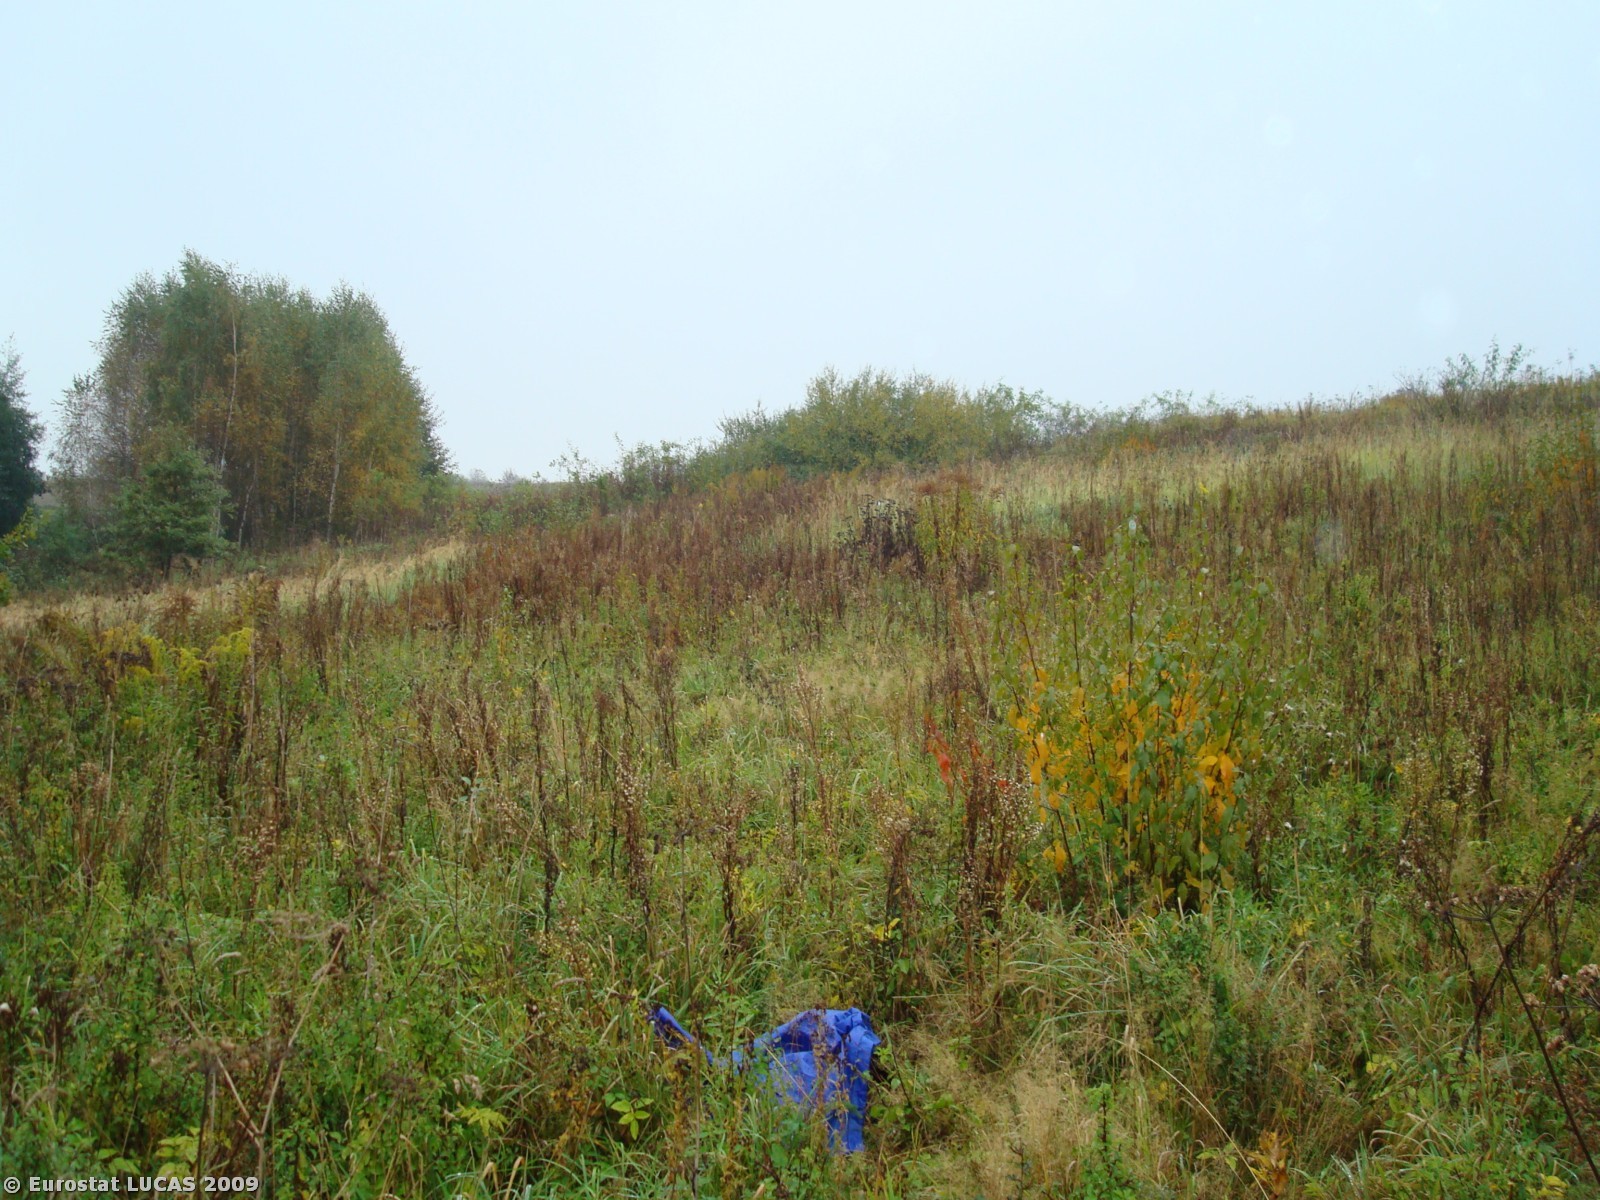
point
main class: Grassland
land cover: Spontaneously vegetated surfaces
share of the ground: > 75 %
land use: Unused
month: September
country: PL
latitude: 49.8320
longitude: 19.6069
